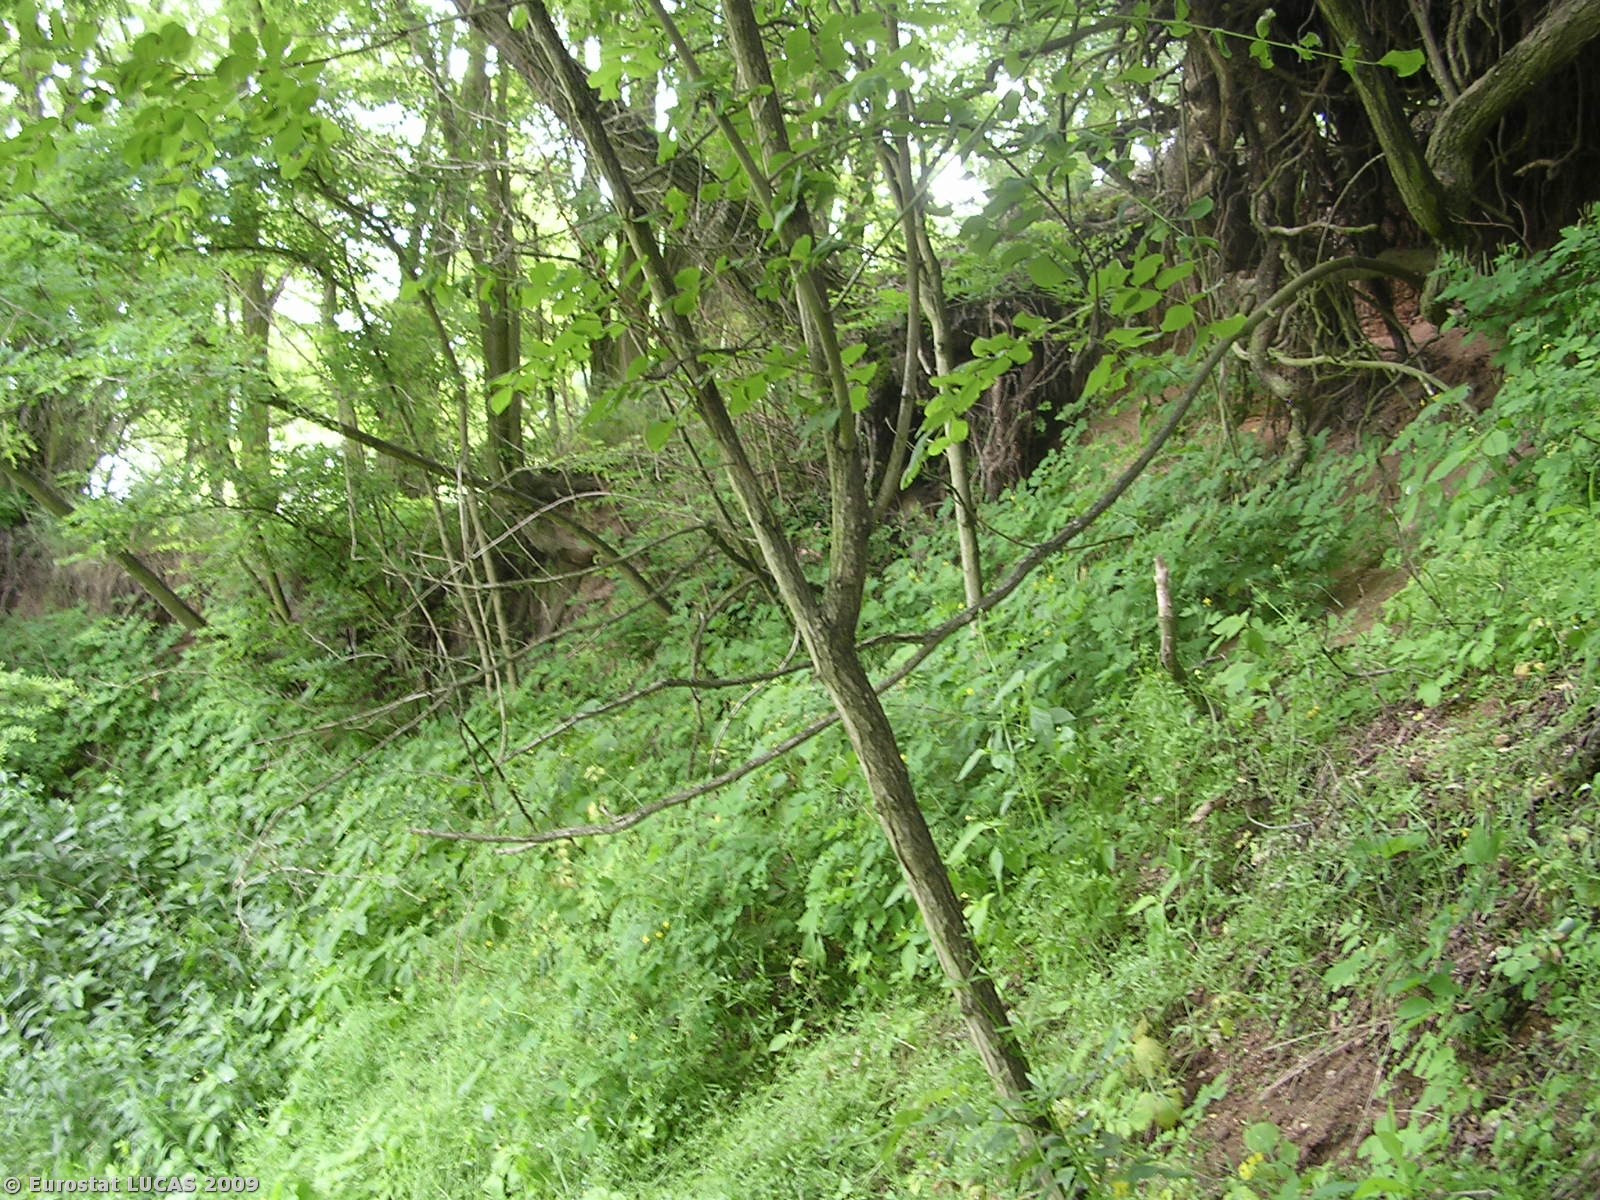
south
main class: Woodland
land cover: Broadleaved woodland
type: plantations and self-sown exotic forest
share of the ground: > 75 %
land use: Unused
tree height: > 5 m
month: June
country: CZ
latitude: 50.5091
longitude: 14.9522
